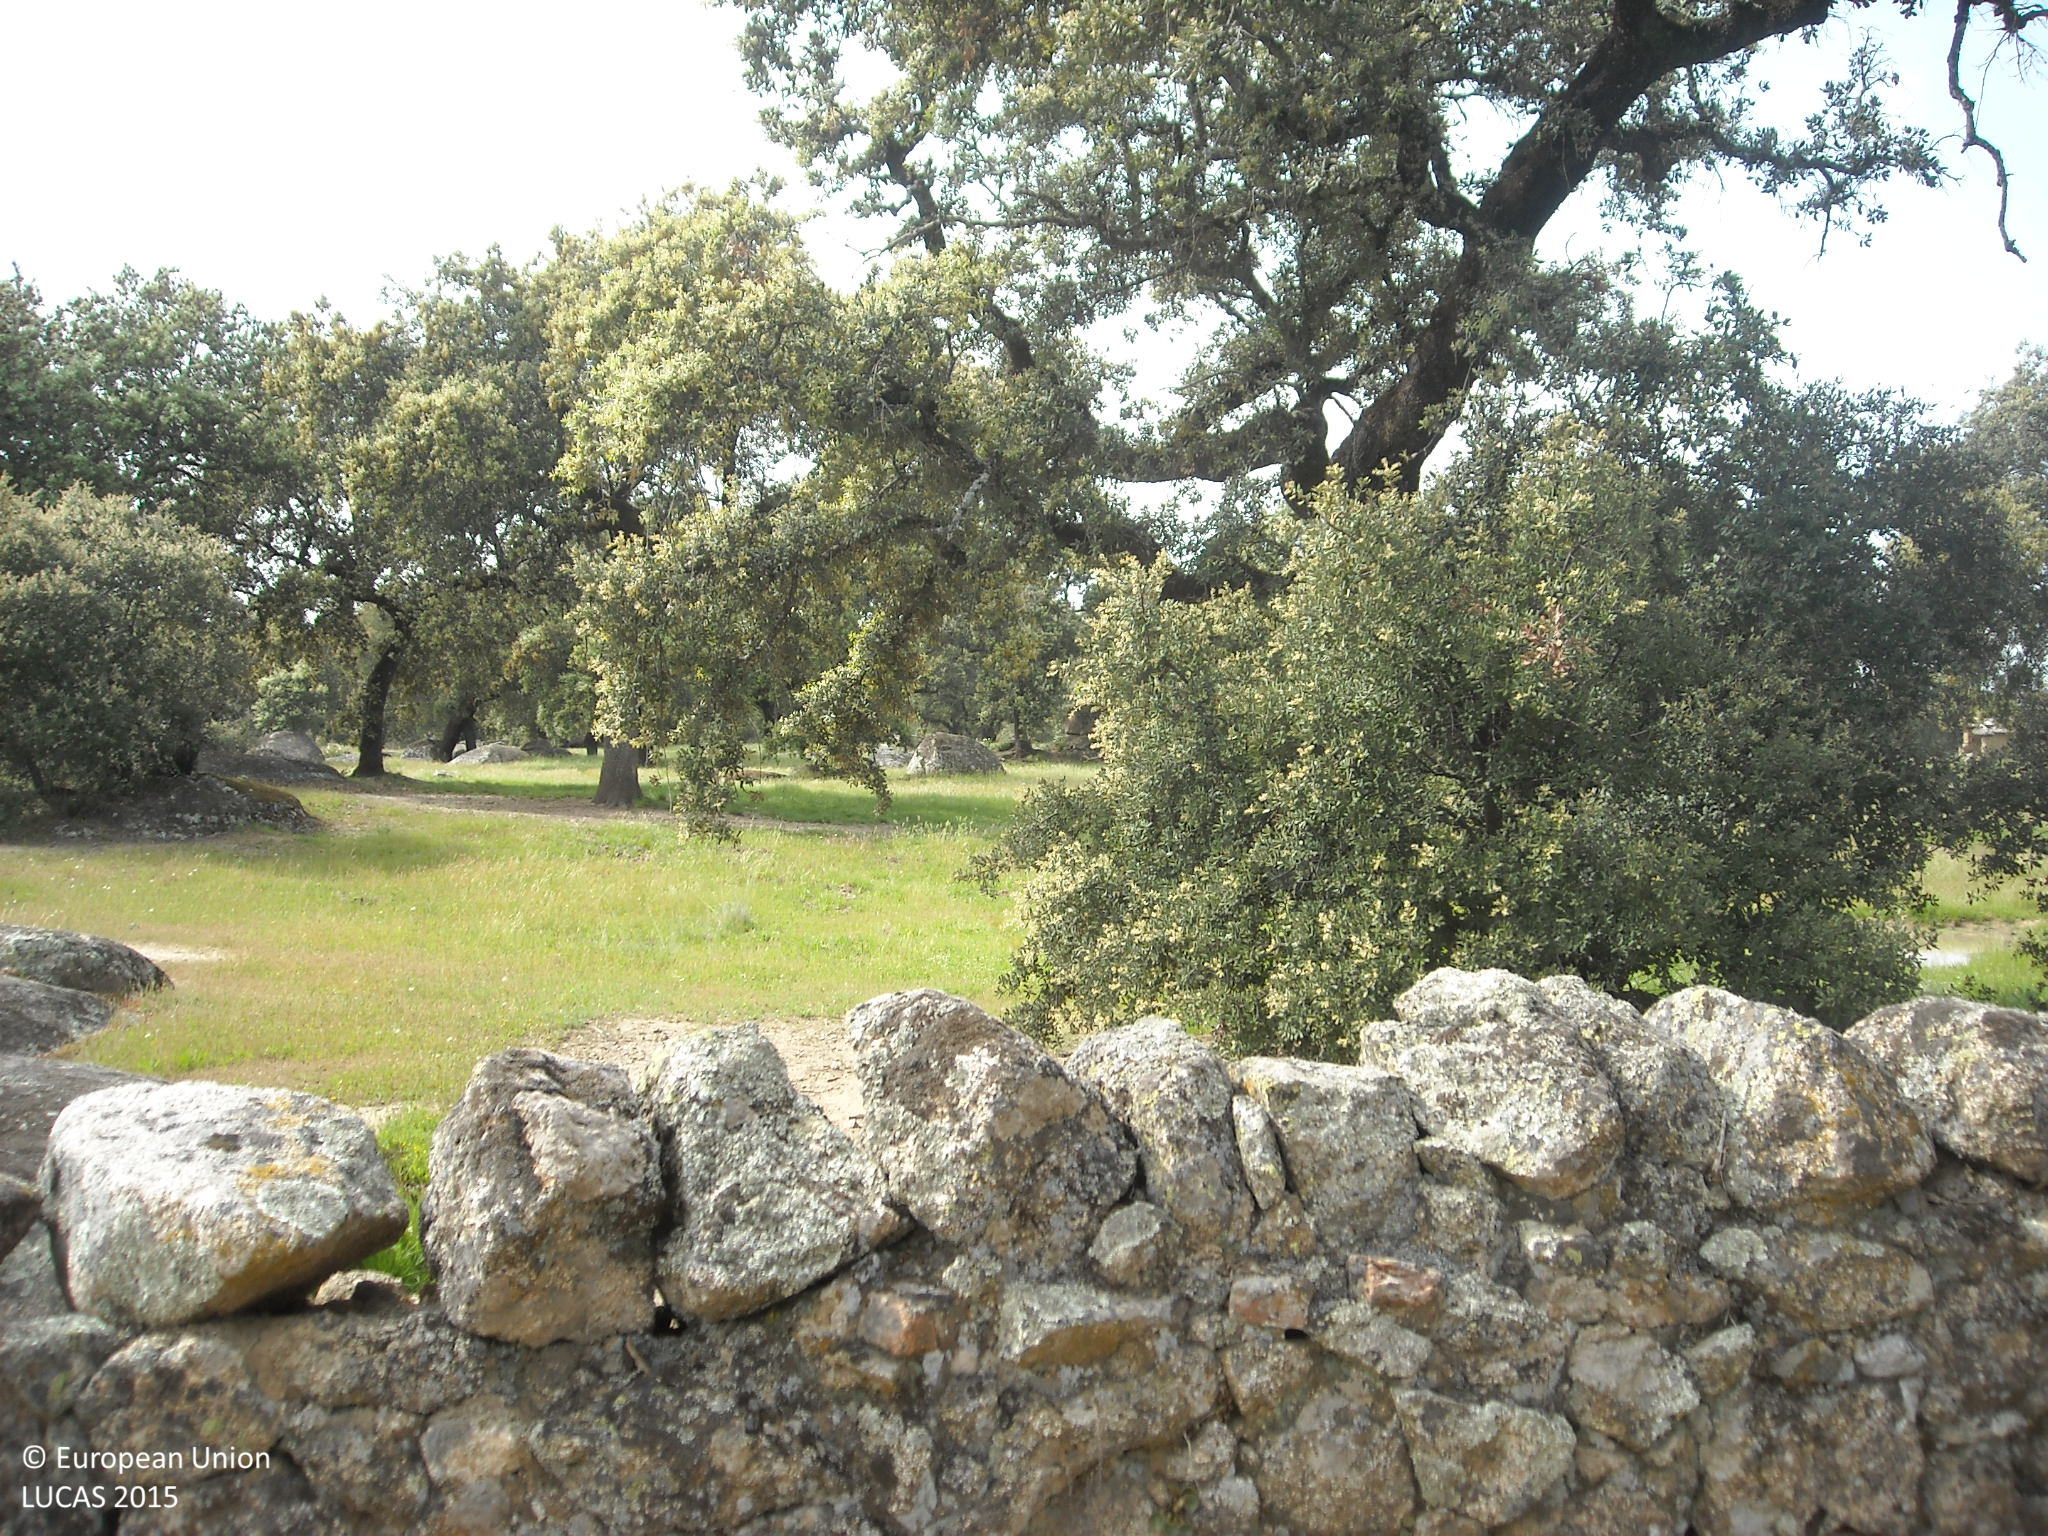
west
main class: Woodland
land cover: Broadleaved woodland
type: broadleaved evergreen forest
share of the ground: 25 - 50 %
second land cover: Grassland without tree/shrub cover
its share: > 75 %
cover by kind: herbaceous plants 65 %, broadleaved forest trees 30 %, shrubs 5 %
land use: Forestry
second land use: Agriculture (excluding fallow land and kitchen gardens)
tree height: > 5 m
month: April
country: ES
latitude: 37.9121
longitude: -6.2232
